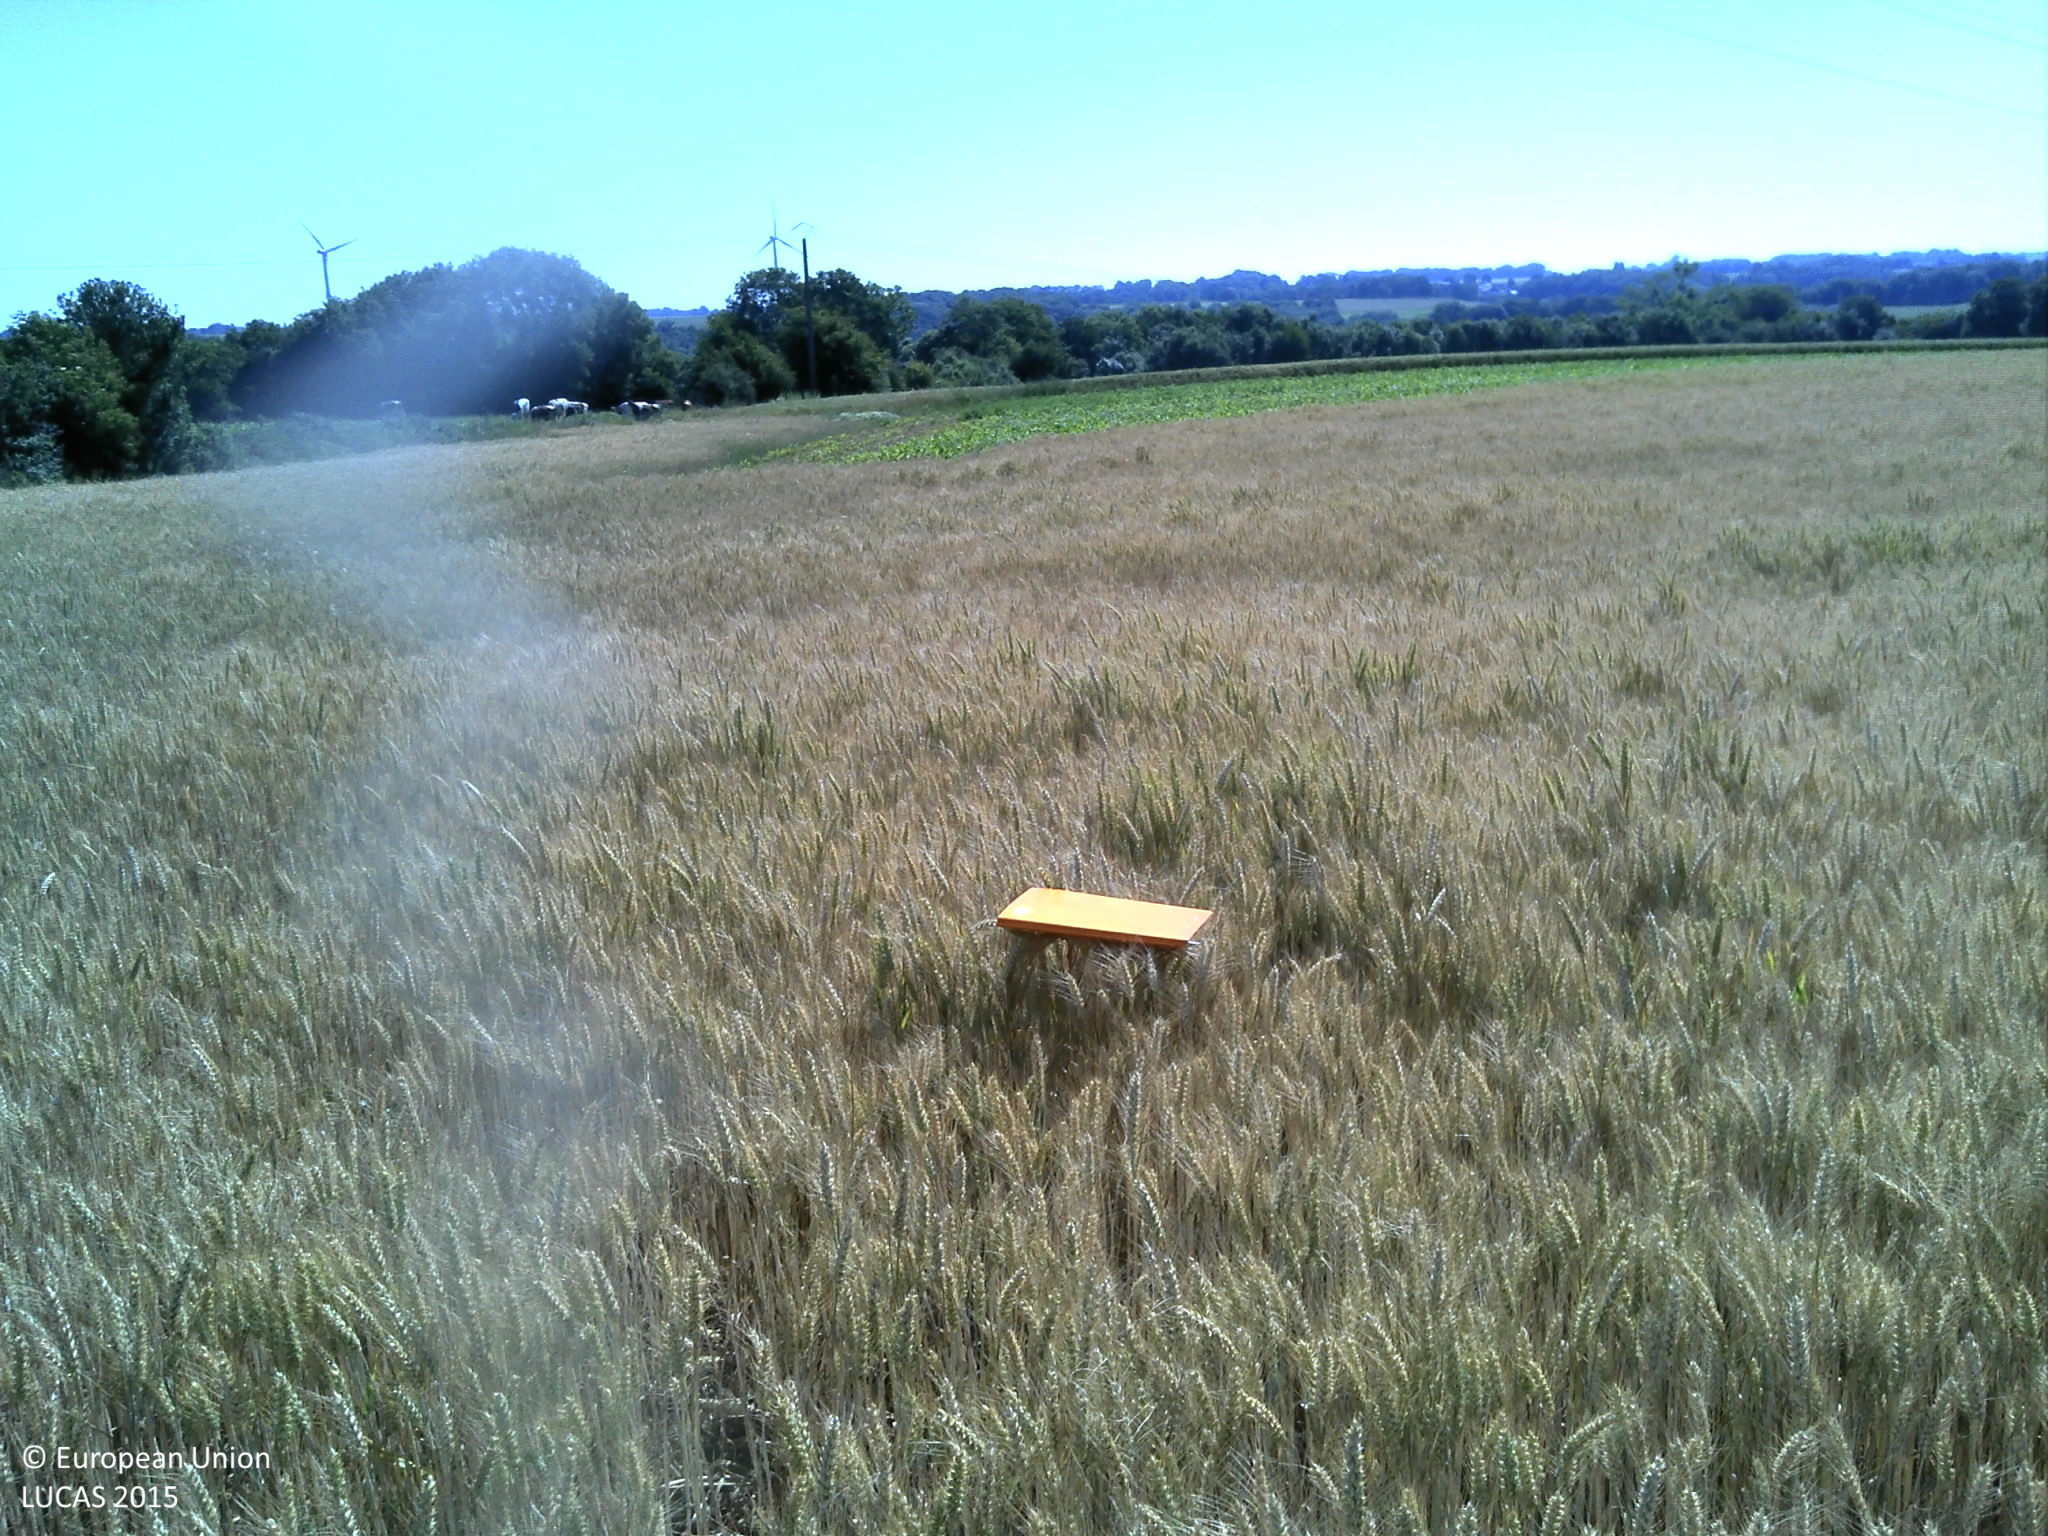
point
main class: Cropland
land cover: Durum wheat
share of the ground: > 75 %
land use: Agriculture (excluding fallow land and kitchen gardens)
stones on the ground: 10 - 25 %
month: June
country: FR
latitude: 49.8420
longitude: 0.9523
